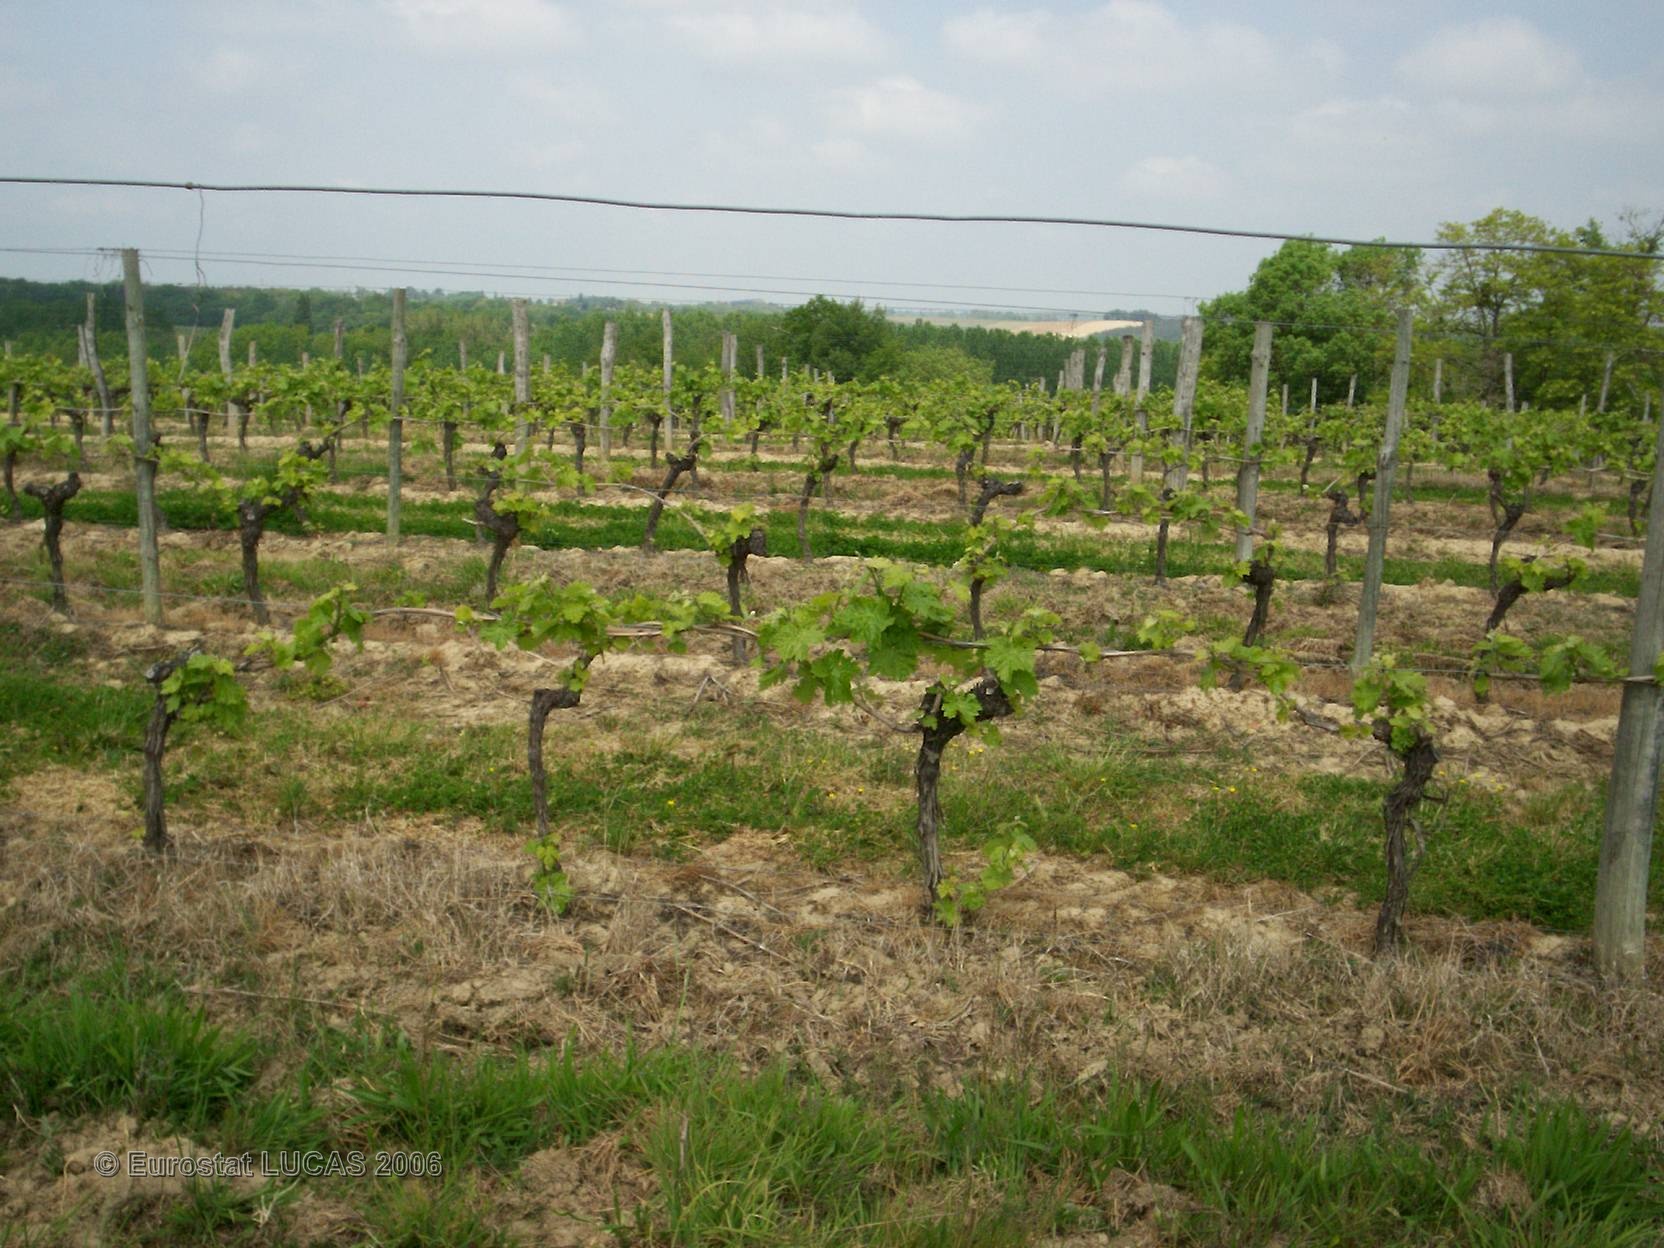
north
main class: Cropland
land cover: Vineyards
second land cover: Grassland with sparse tree/shrub cover
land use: Agriculture (excluding fallow land and kitchen gardens)
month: May
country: FR
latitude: 43.8831
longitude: 0.1732
